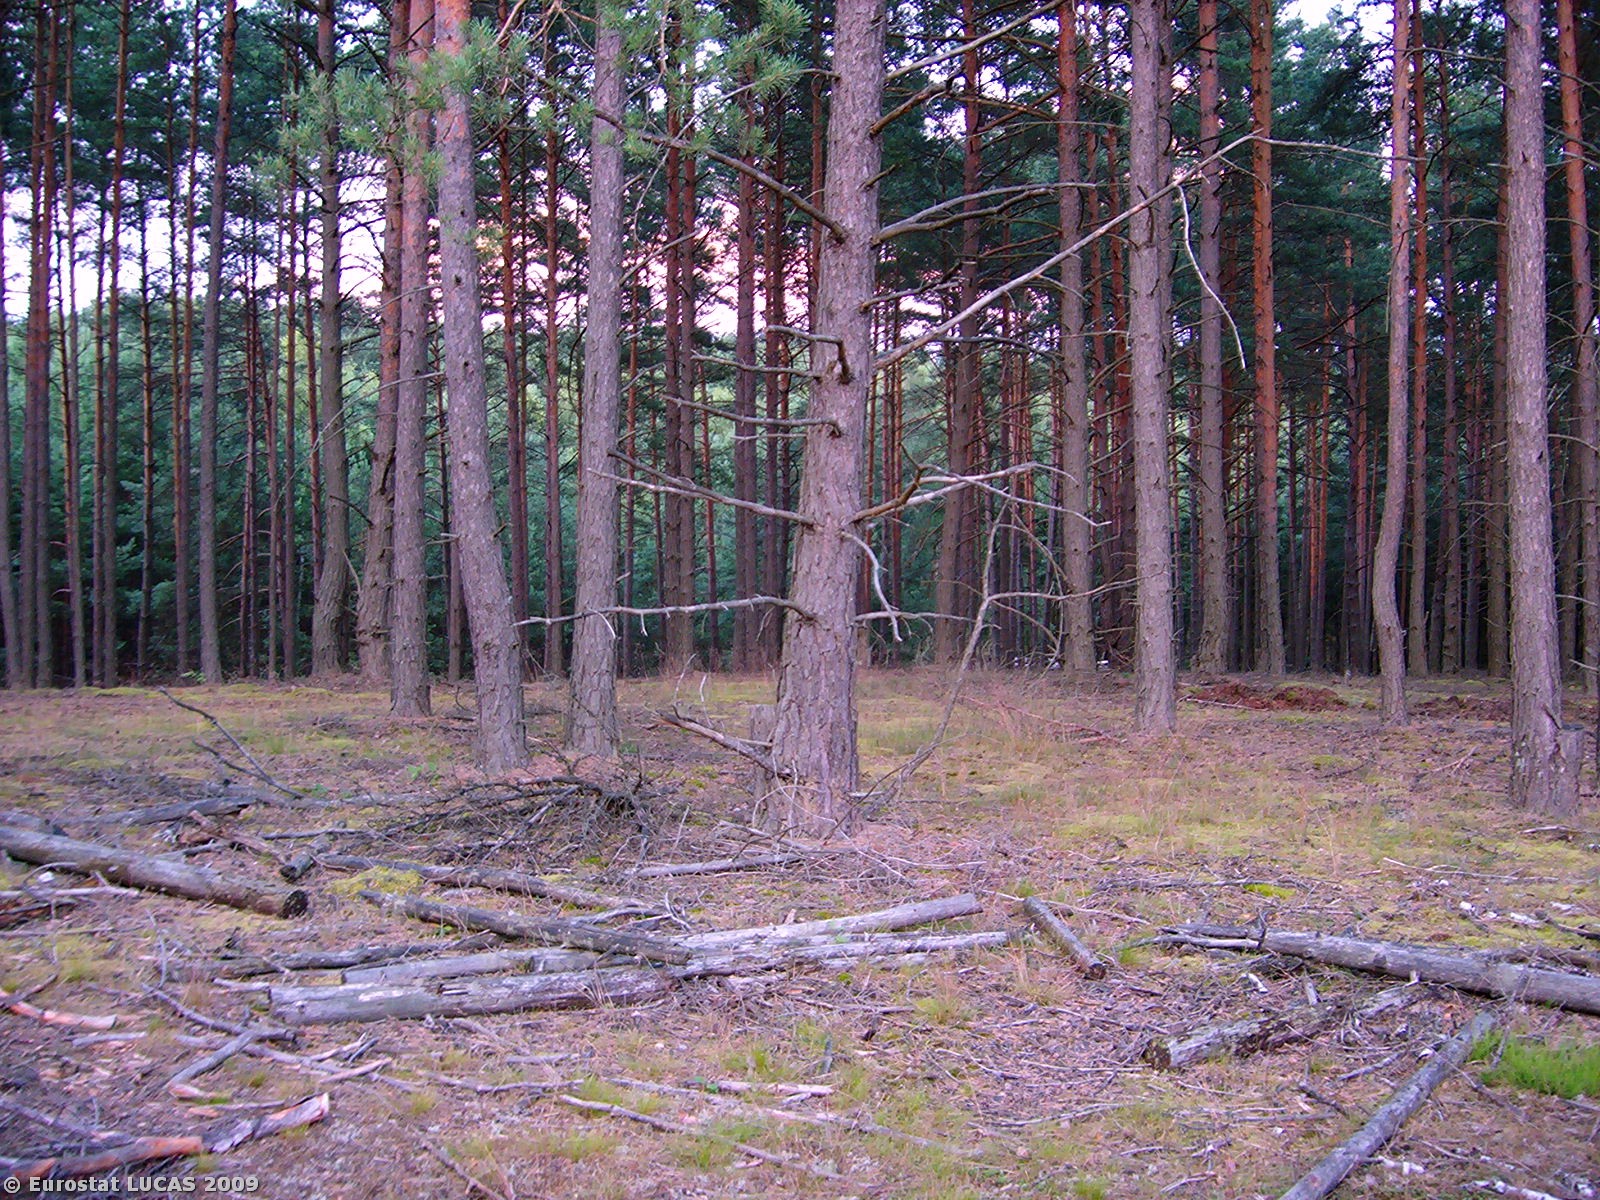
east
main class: Woodland
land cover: Coniferous woodland
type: hemiboreal forest and nemoral coniferous forest and mixed broadleaved-coniferous forest
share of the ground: > 75 %
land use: Forestry
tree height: > 5 m
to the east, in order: Coniferous woodland; Tracks; Coniferous woodland; Tracks; Coniferous woodland
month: July
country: PL
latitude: 52.2493
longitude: 15.1149
